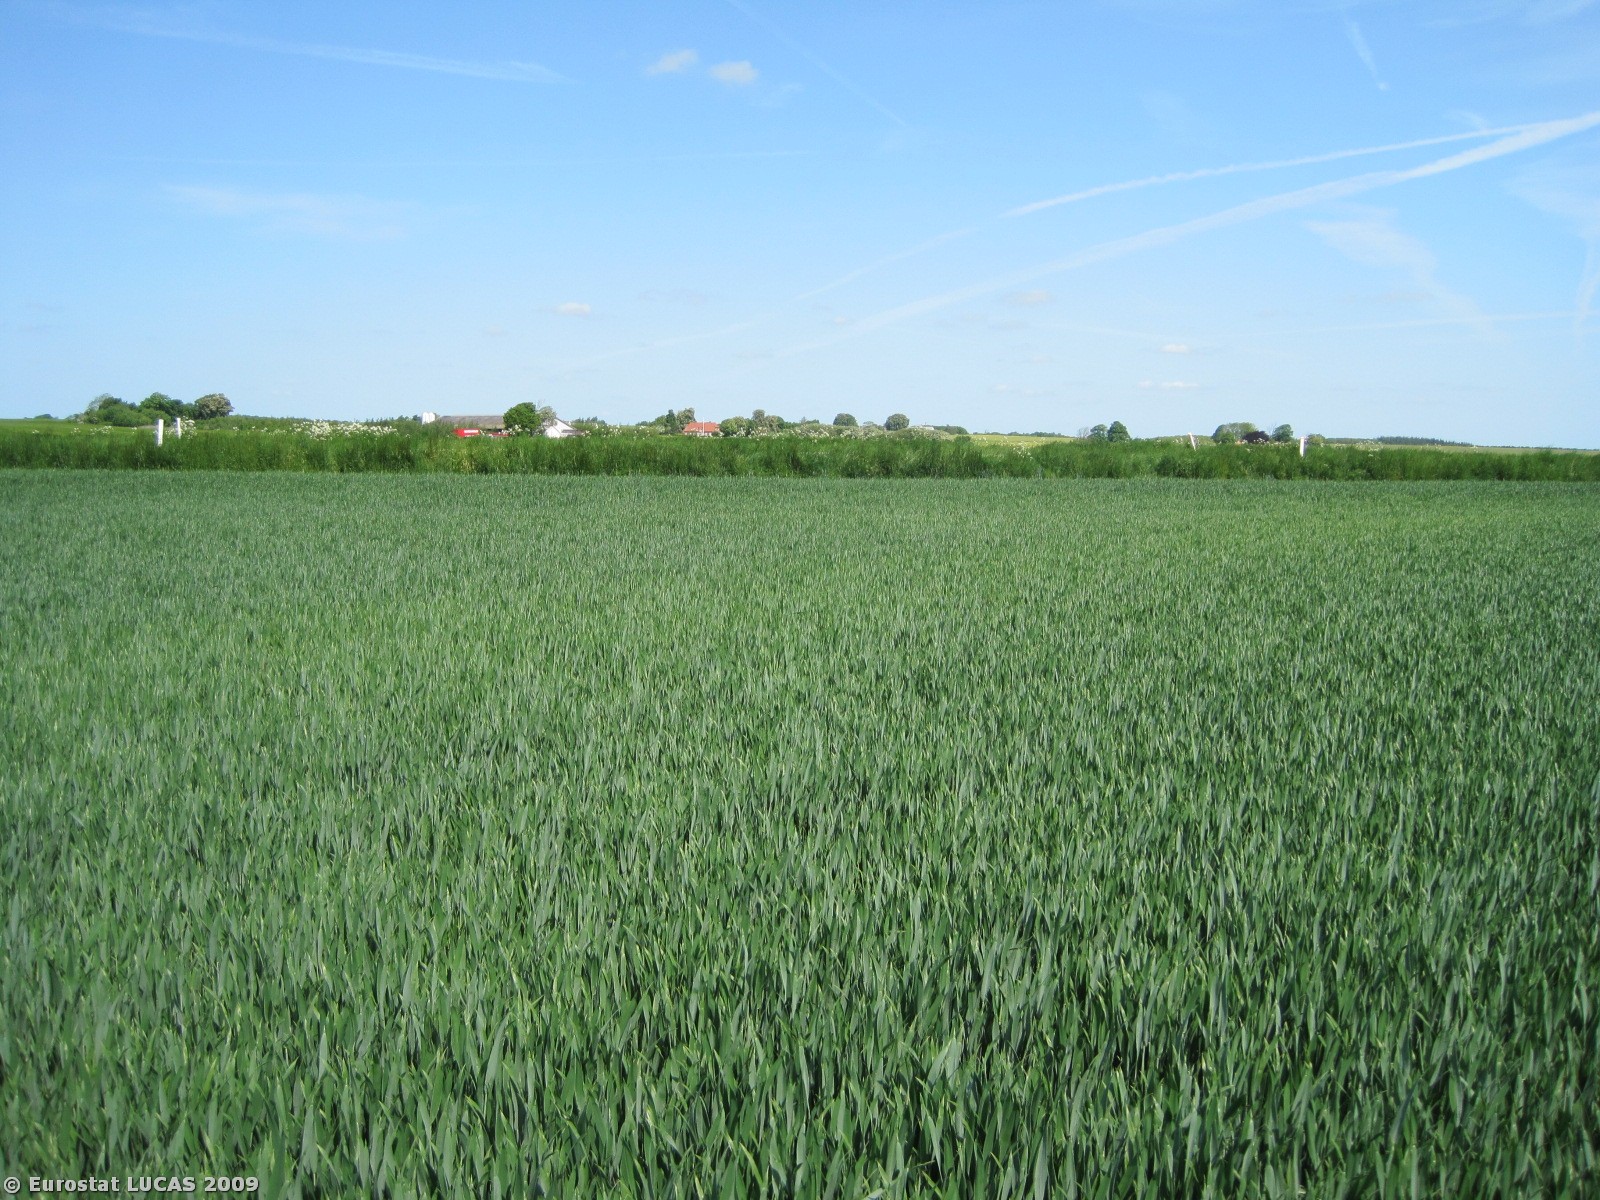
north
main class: Cropland
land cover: Common wheat
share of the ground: > 75 %
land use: Agriculture (excluding fallow land and kitchen gardens)
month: May
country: DK
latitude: 56.5112
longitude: 10.1785
